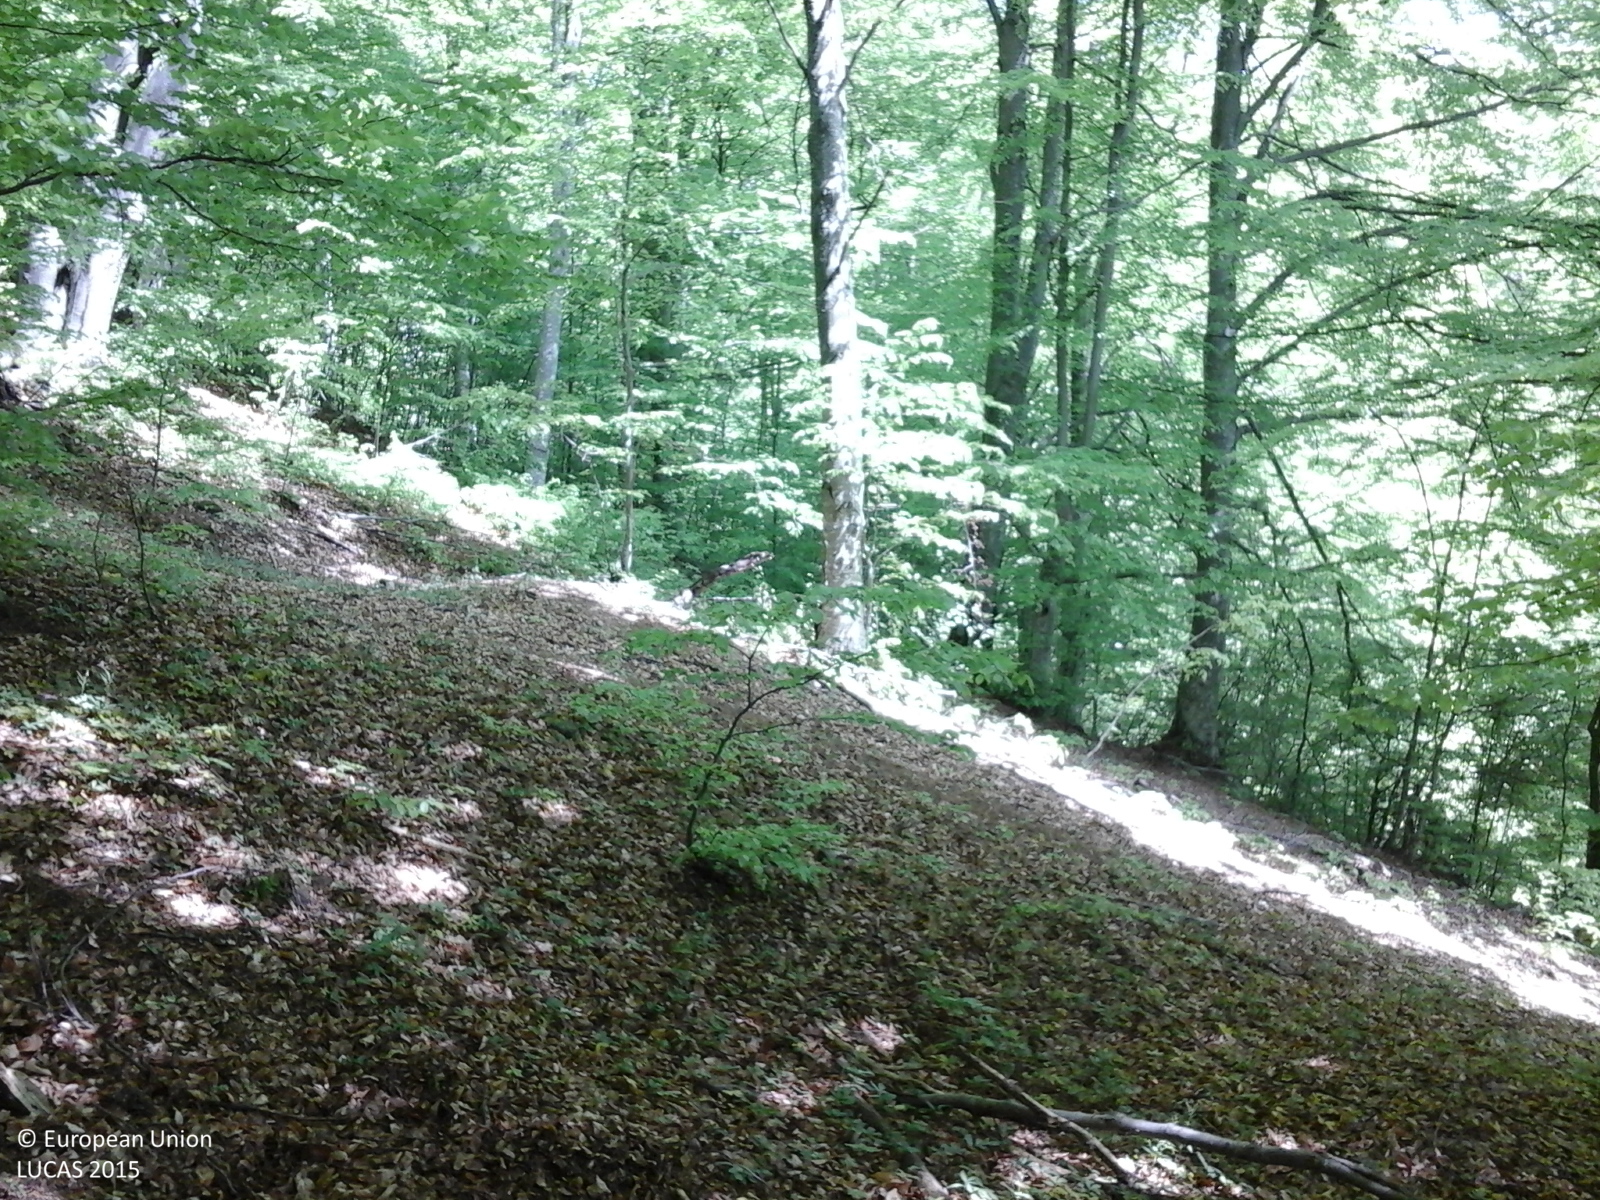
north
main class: Woodland
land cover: Broadleaved woodland
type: beech forest
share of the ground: > 75 %
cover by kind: broadleaved forest trees 100 %
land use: Forestry
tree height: > 5 m
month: May
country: RO
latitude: 45.7052
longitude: 26.0032
